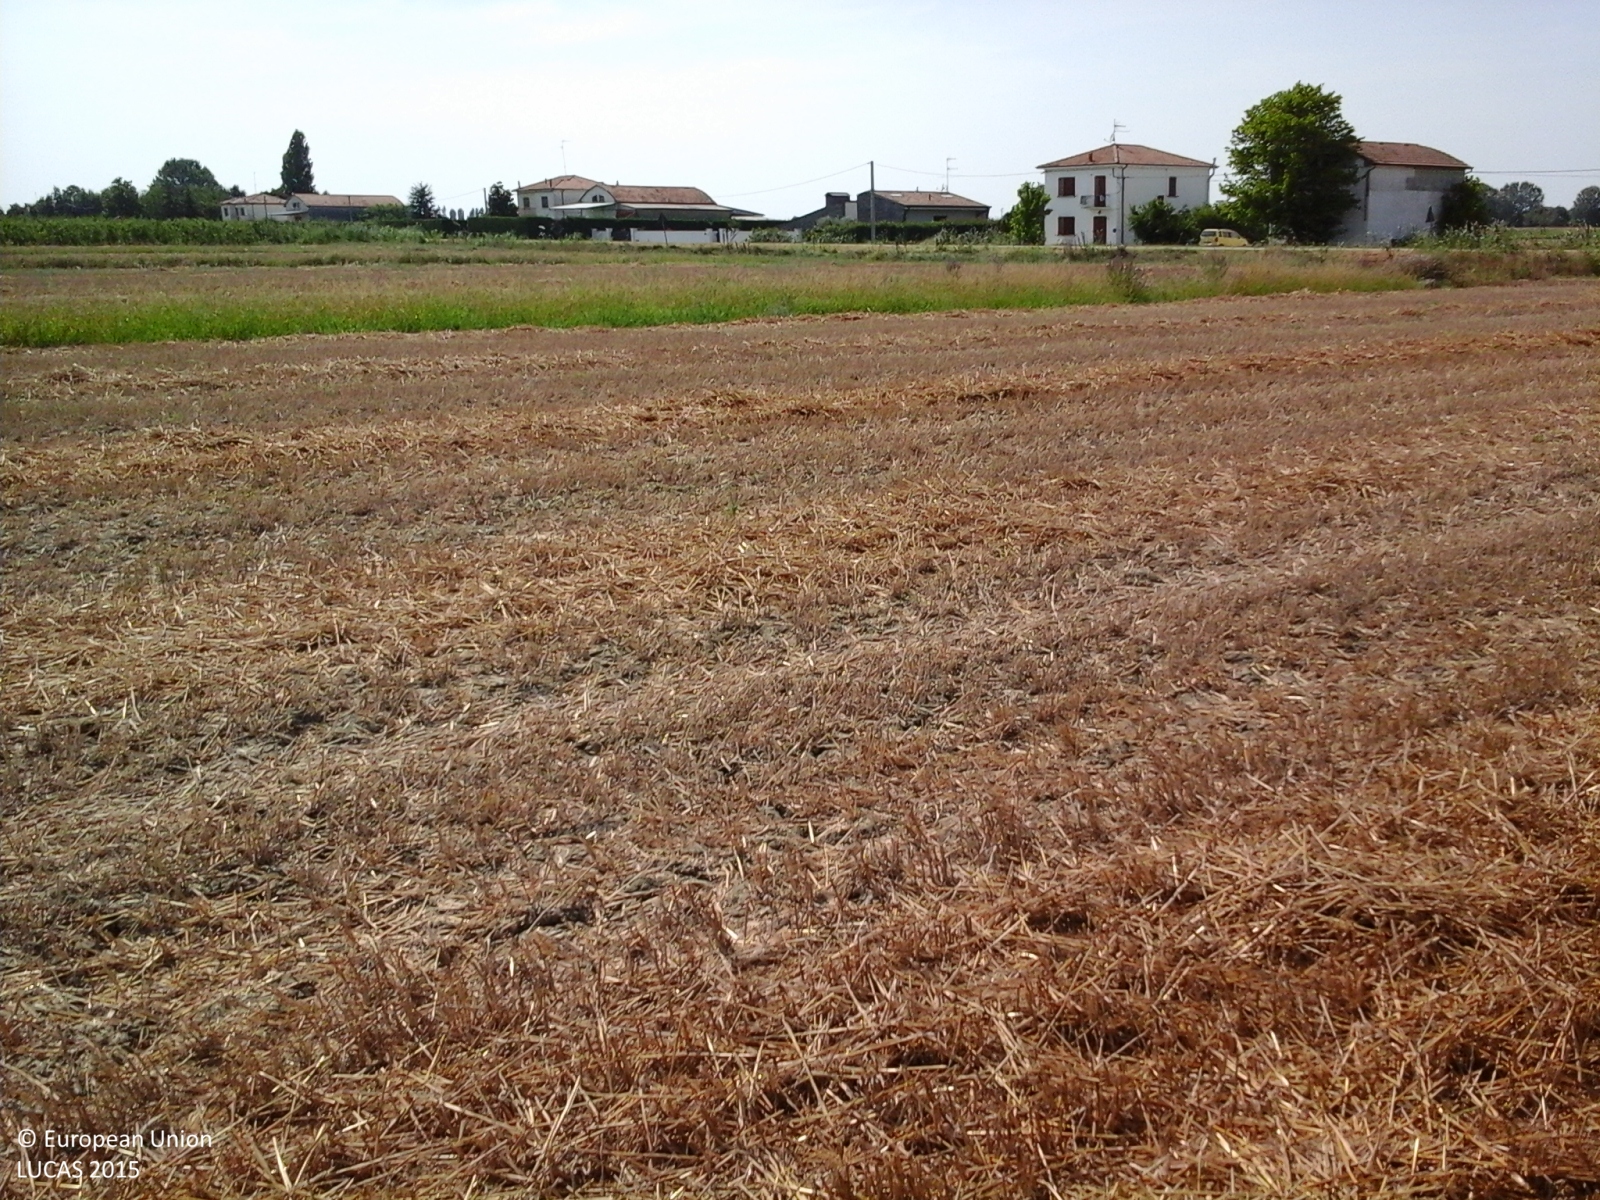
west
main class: Cropland
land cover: Common wheat
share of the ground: > 75 %
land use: Agriculture (excluding fallow land and kitchen gardens)
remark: Harvested field
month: July
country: IT
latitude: 44.7170
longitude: 11.6000
